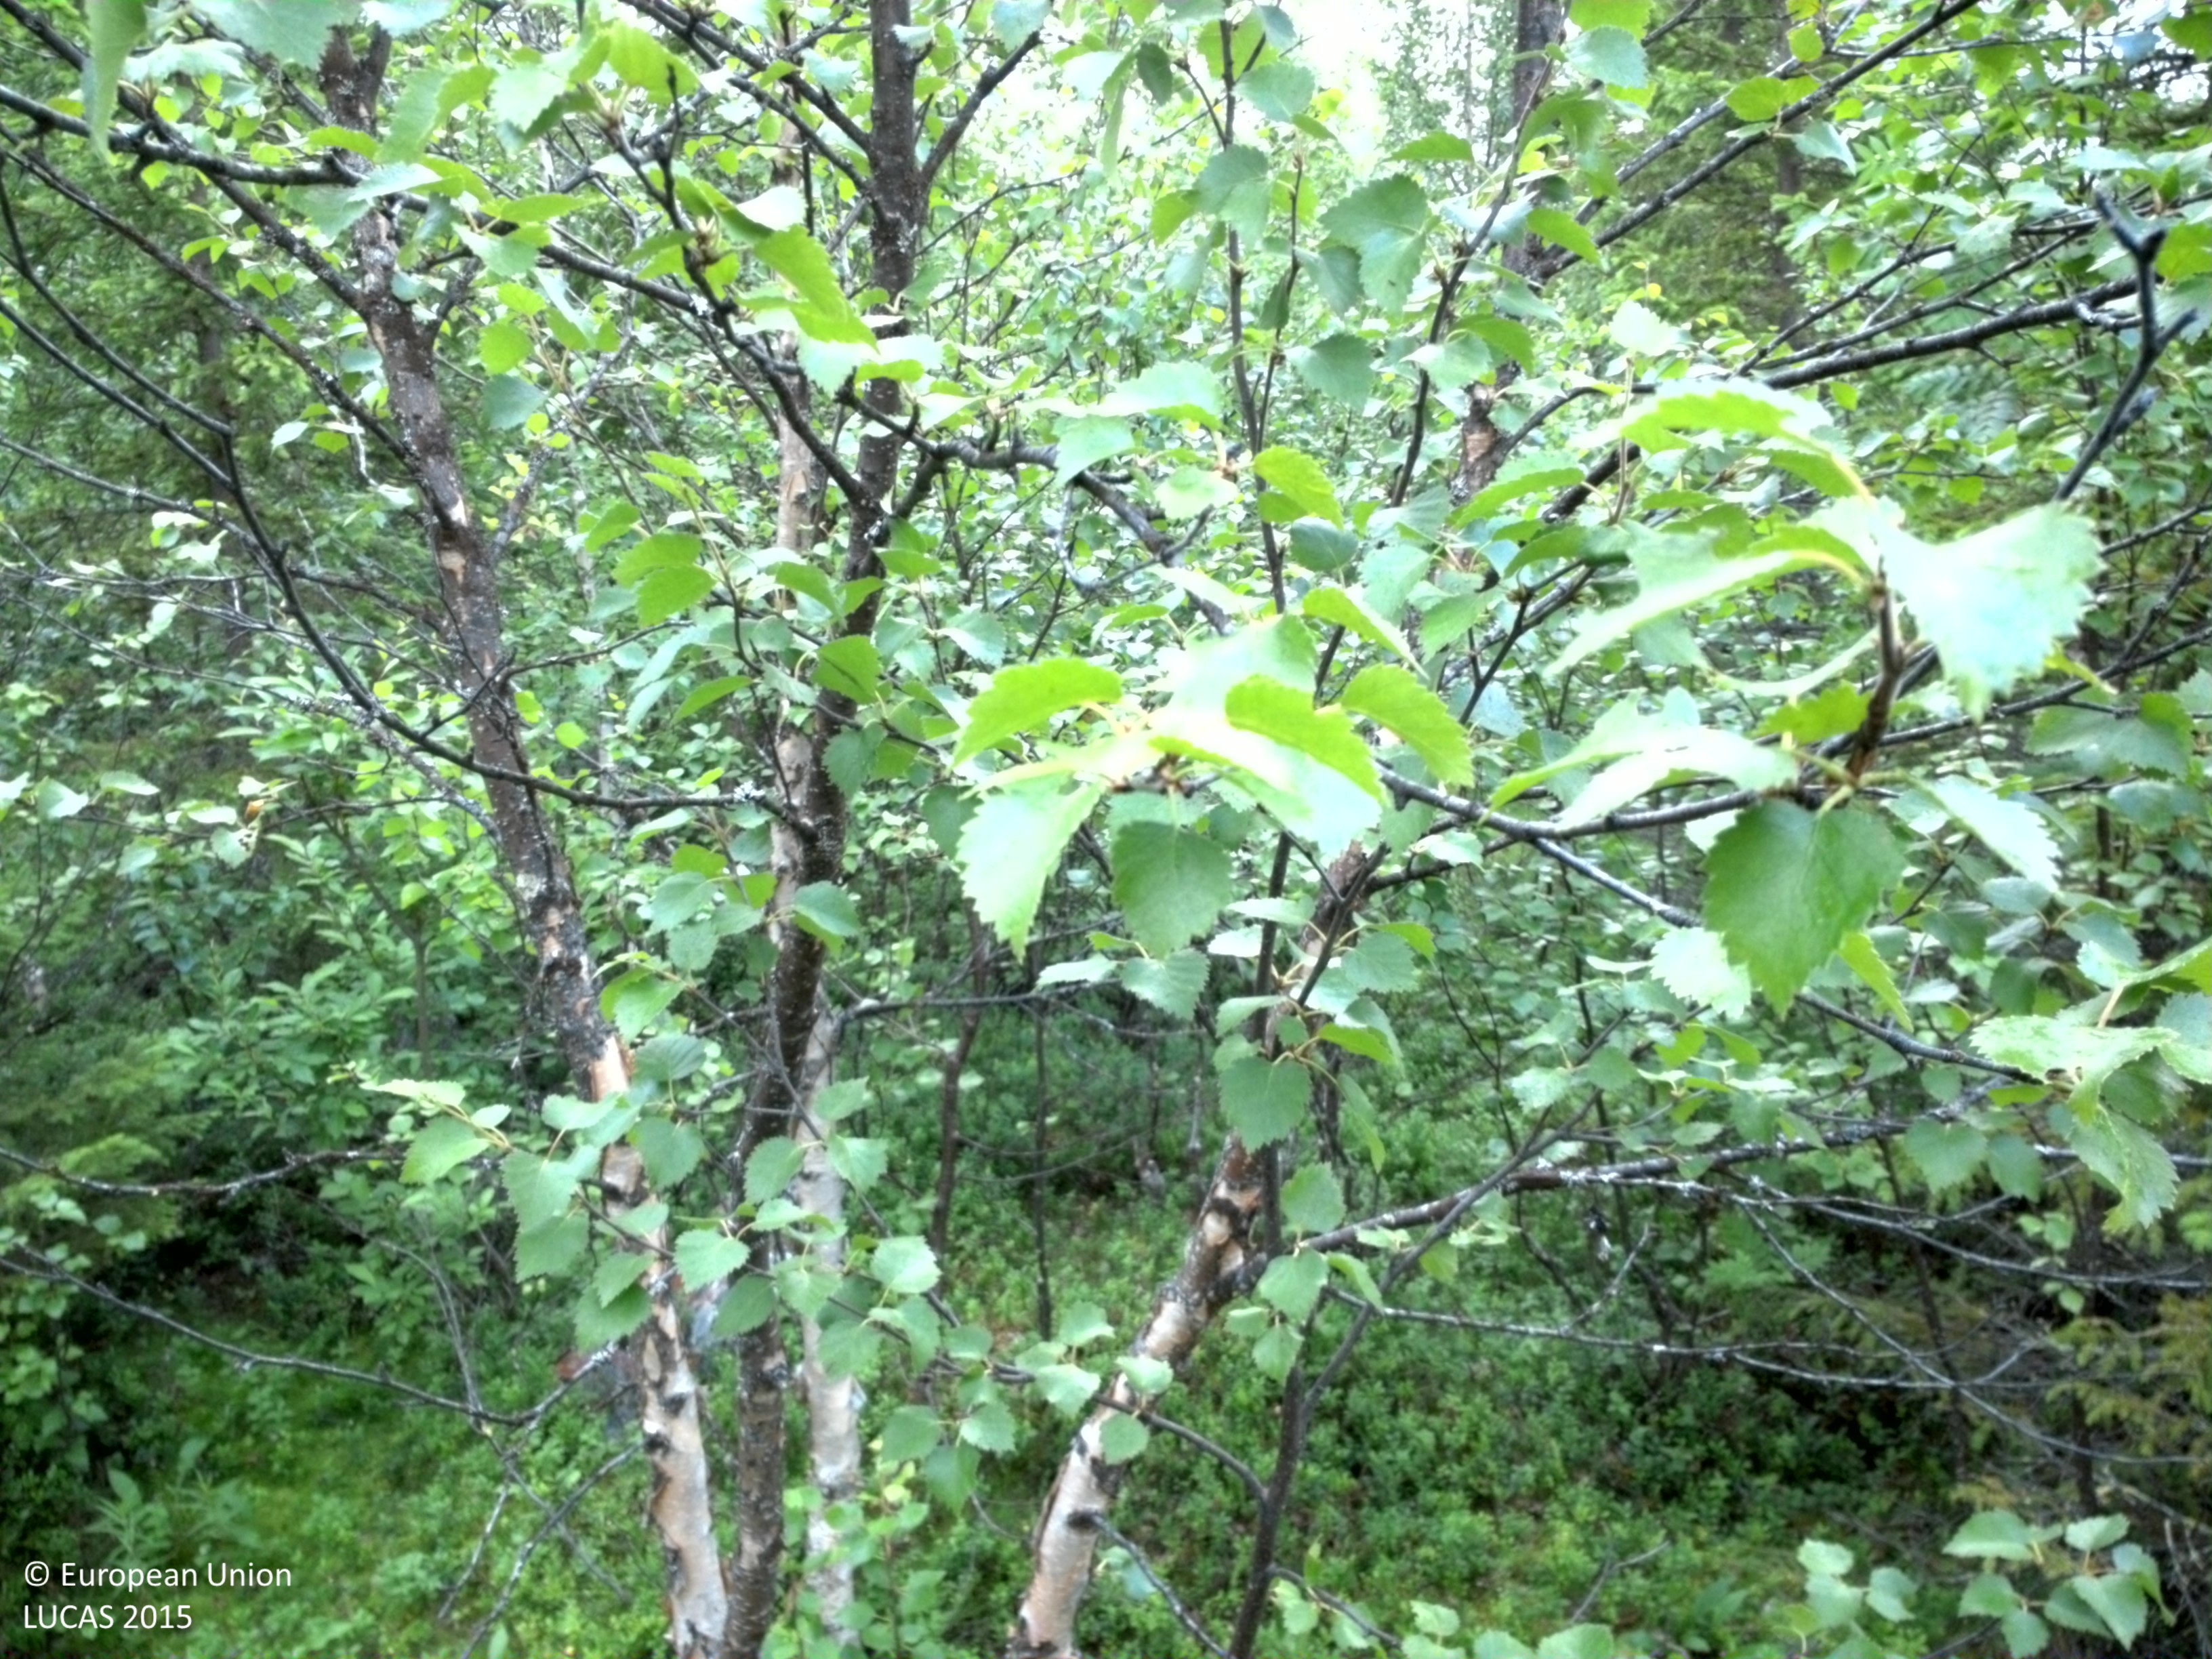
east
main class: Woodland
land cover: Spruce dominated mixed woodland
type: boreal forest
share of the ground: 25 - 50 %
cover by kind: shrubs 40 %, broadleaved forest trees 25 %, coniferous forest trees 15 %, lichens and mosses 15 %, herbaceous plants 5 %
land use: Forestry
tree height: > 5 m
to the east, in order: Spruce dominated mixed woodland; Shrubland with sparse tree cover
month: August
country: SE
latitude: 64.8377
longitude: 16.2267
